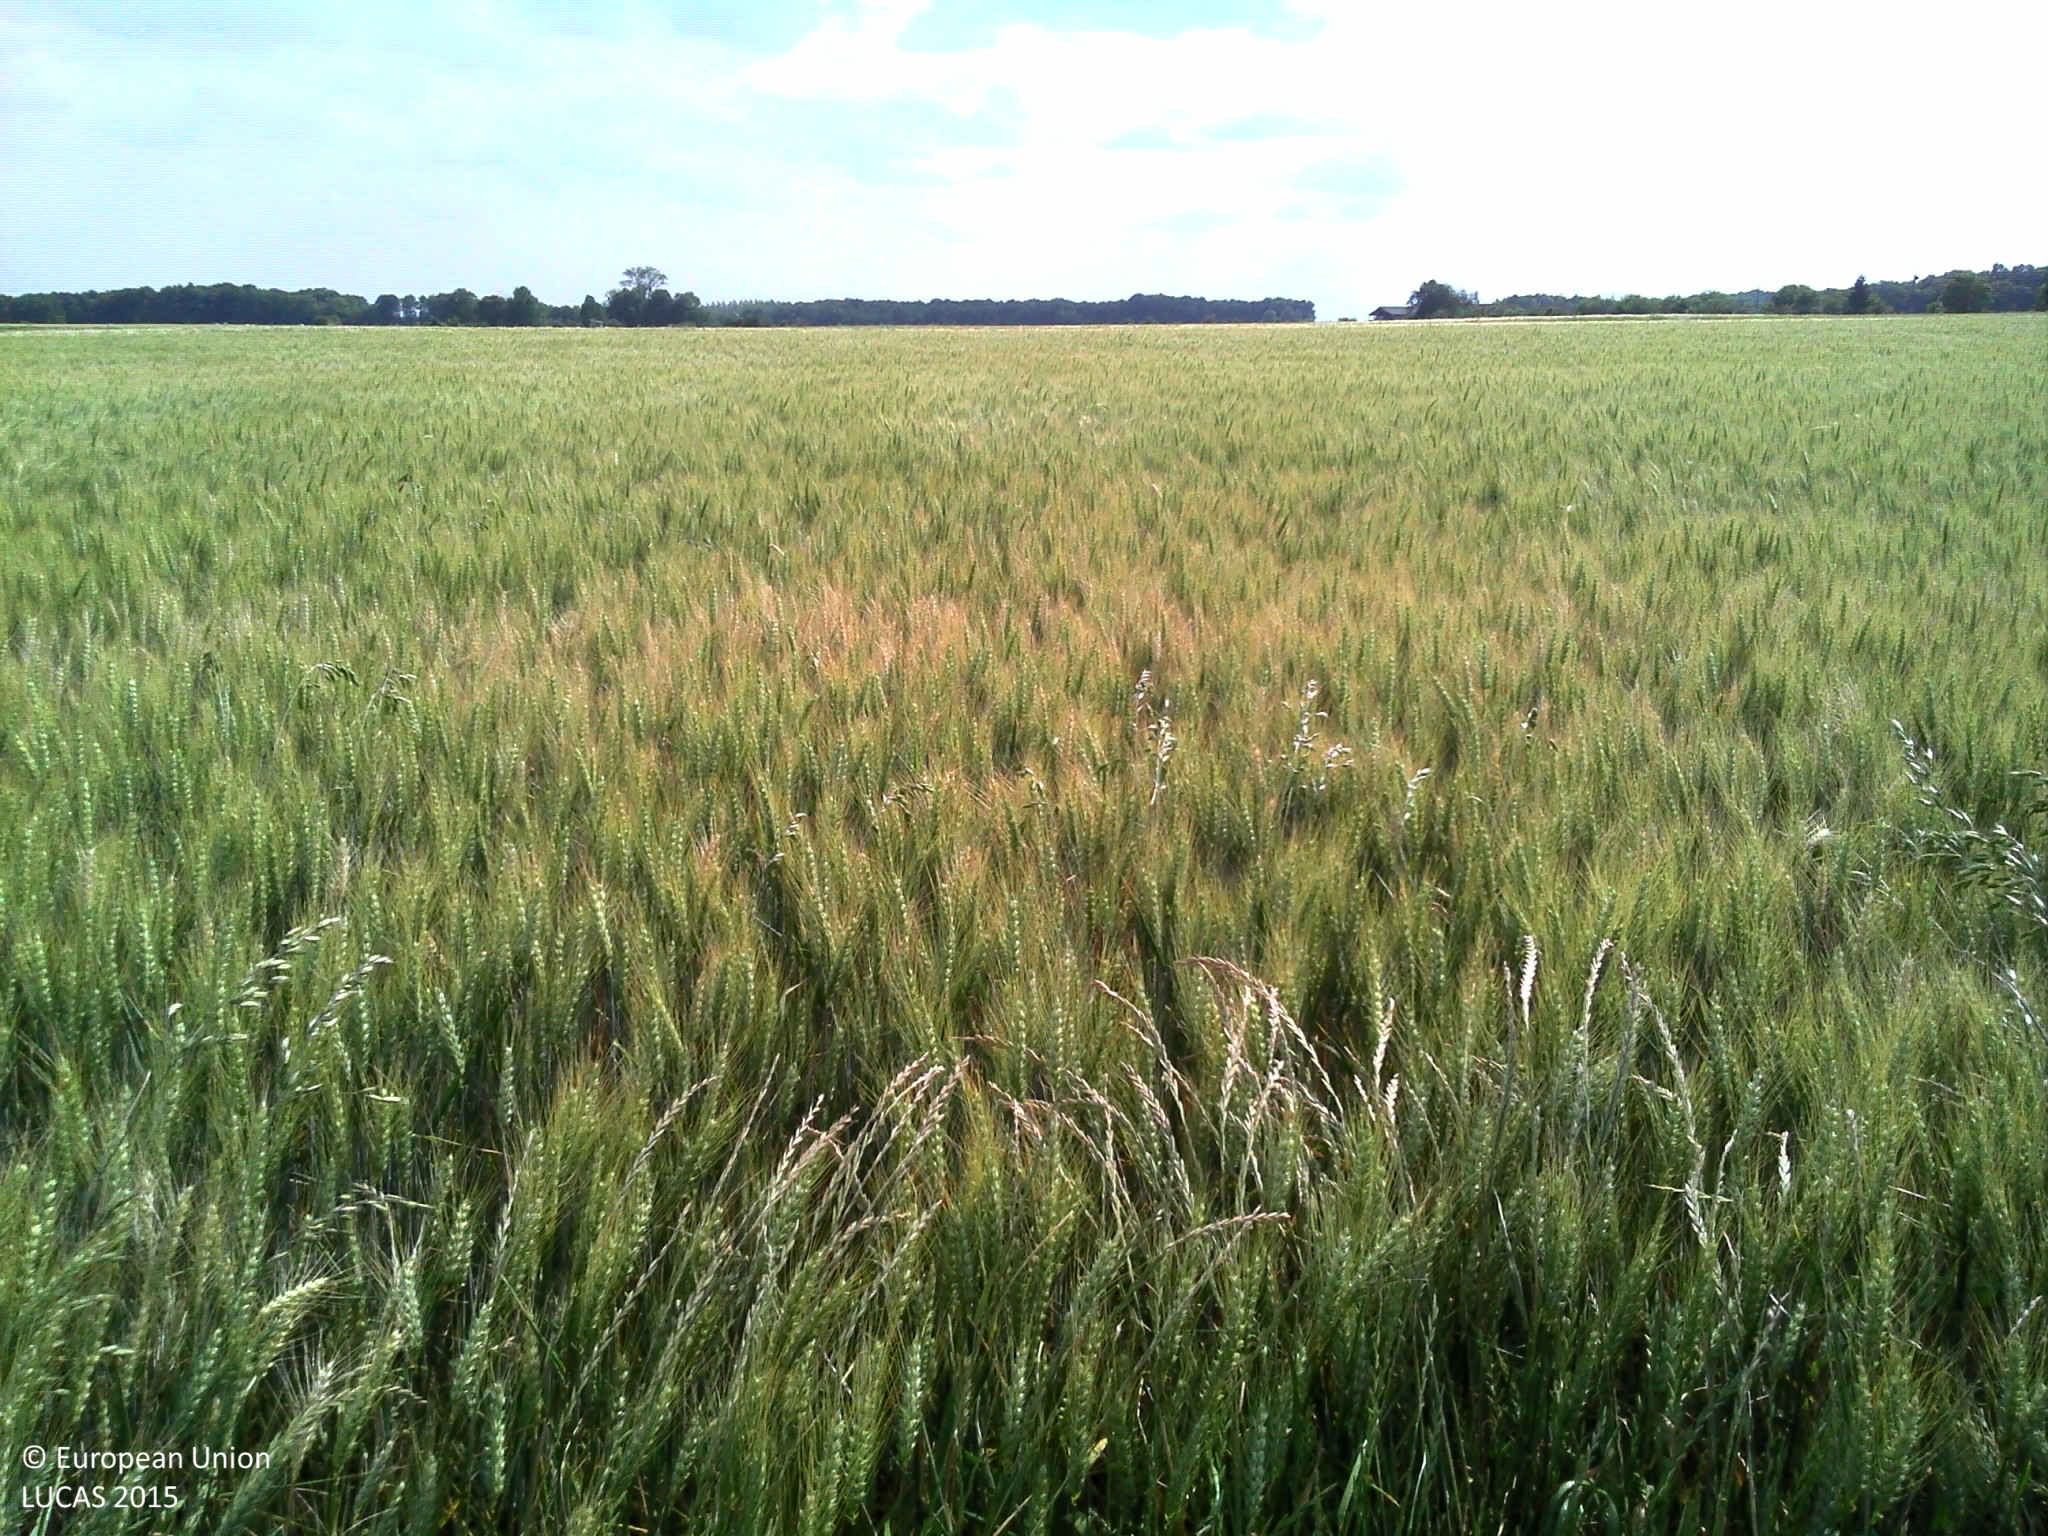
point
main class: Cropland
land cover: Common wheat
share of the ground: > 75 %
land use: Agriculture (excluding fallow land and kitchen gardens)
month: June
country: FR
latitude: 46.8595
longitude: 0.1800
